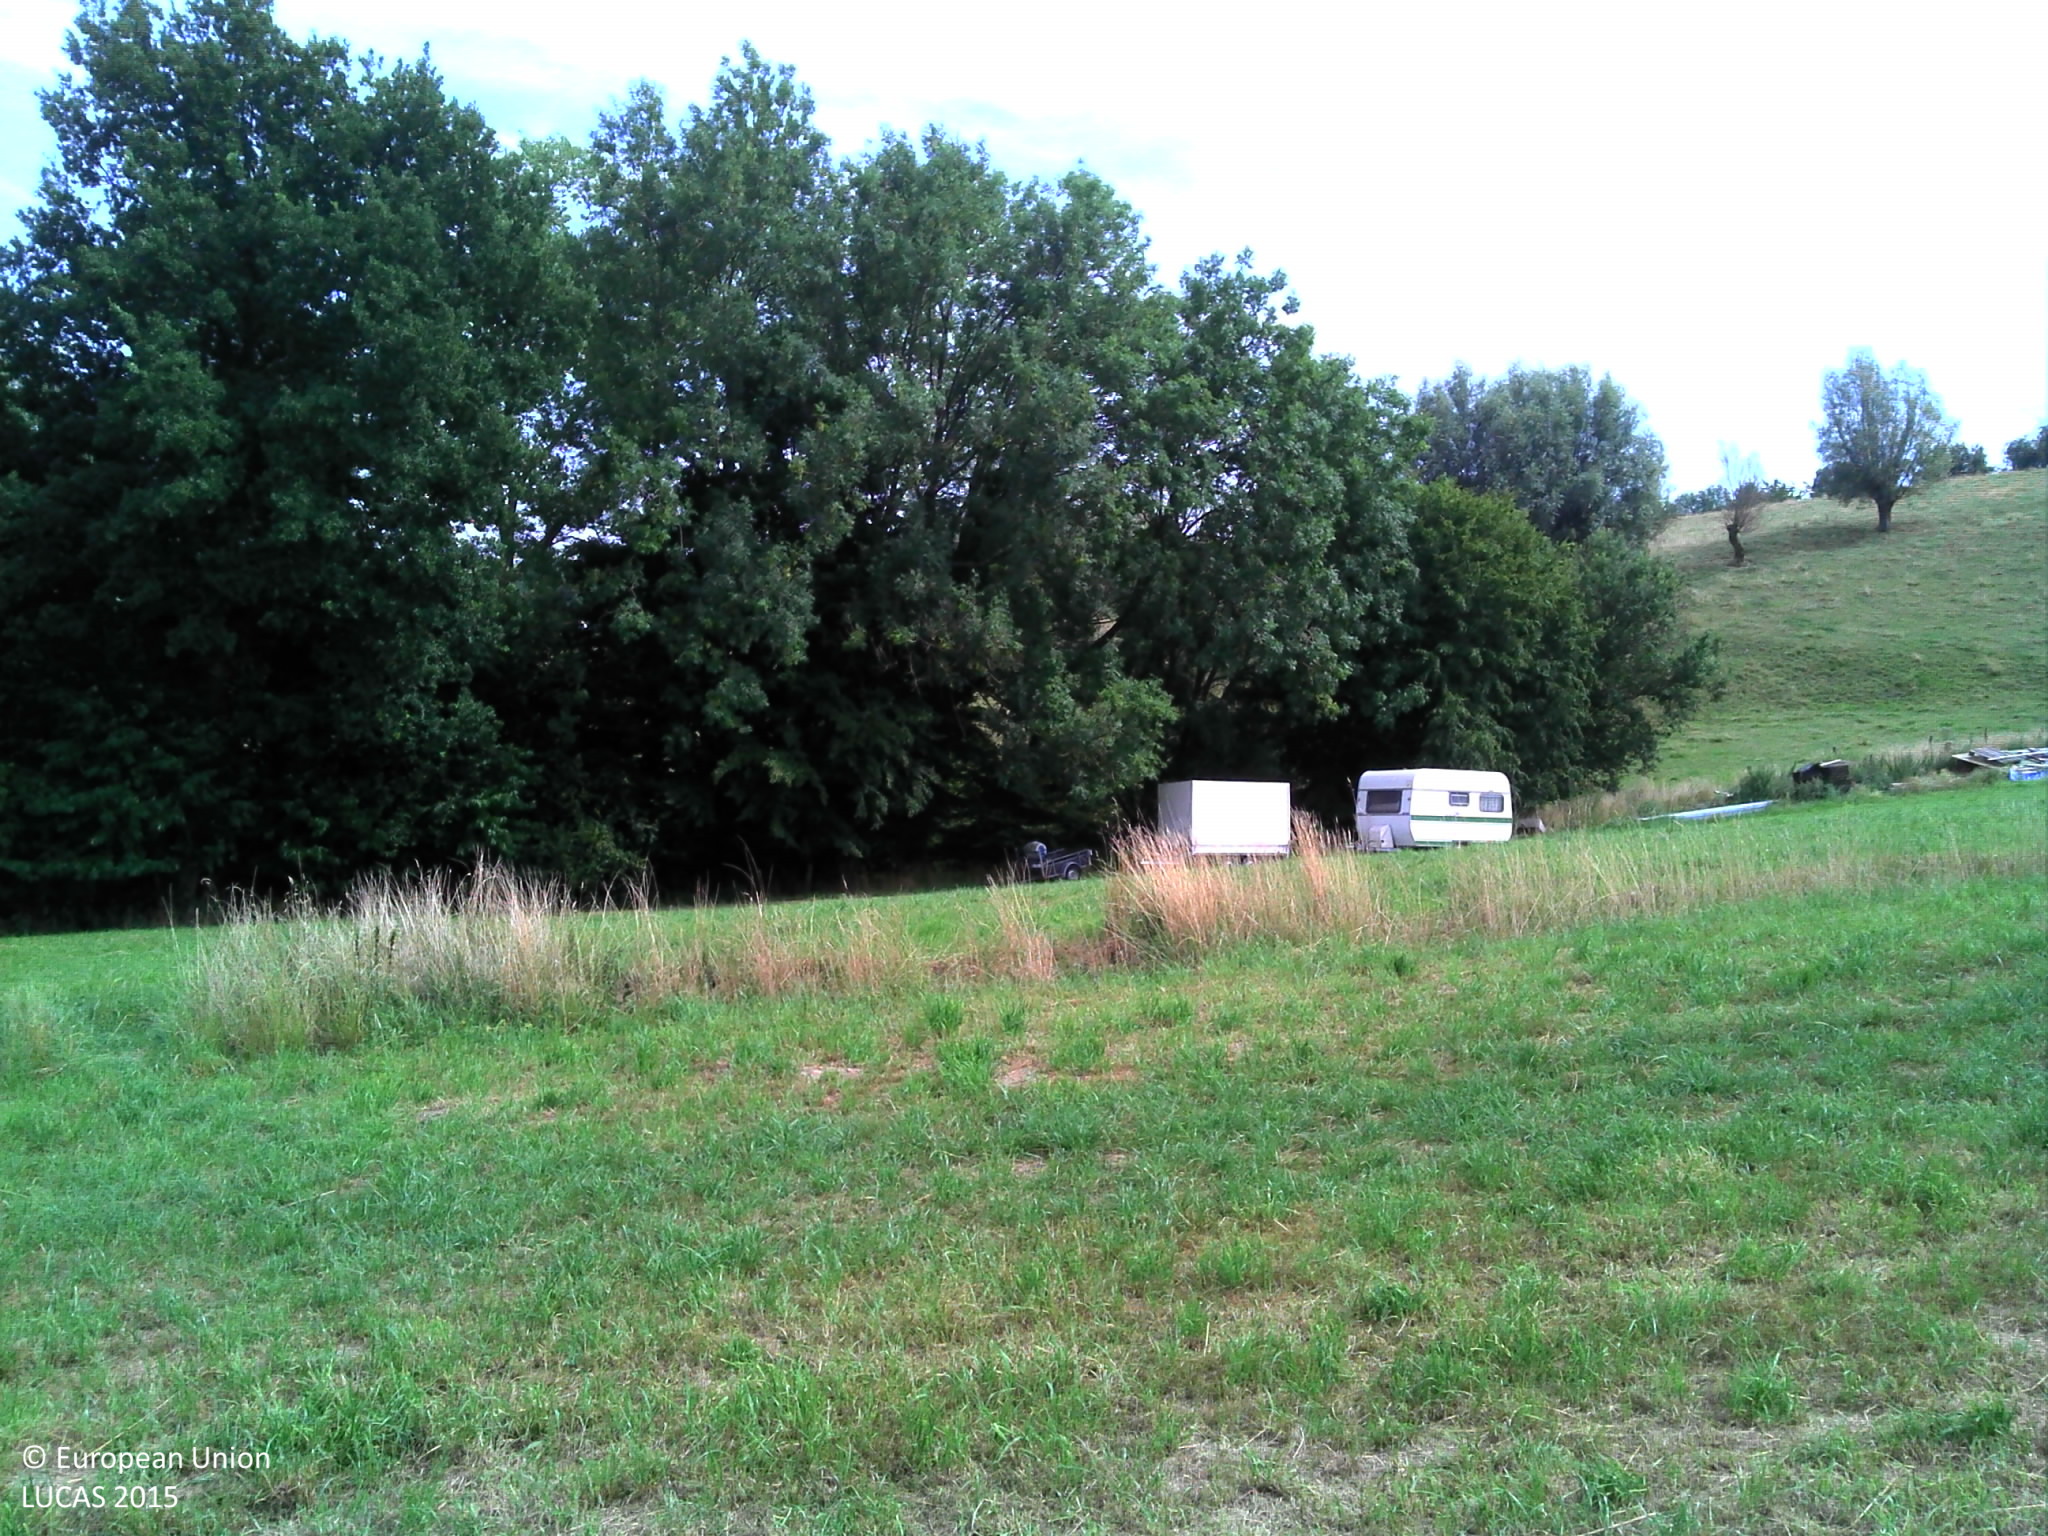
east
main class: Grassland
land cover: Grassland without tree/shrub cover
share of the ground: > 75 %
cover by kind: herbaceous plants 100 %
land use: Agriculture (excluding fallow land and kitchen gardens)
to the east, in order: Grassland without tree/shrub cover; Fences; Broadleaved woodland; Grassland without tree/shrub cover; Fences; Grassland without tree/shrub cover
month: August
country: BE
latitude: 50.7487
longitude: 3.6860
